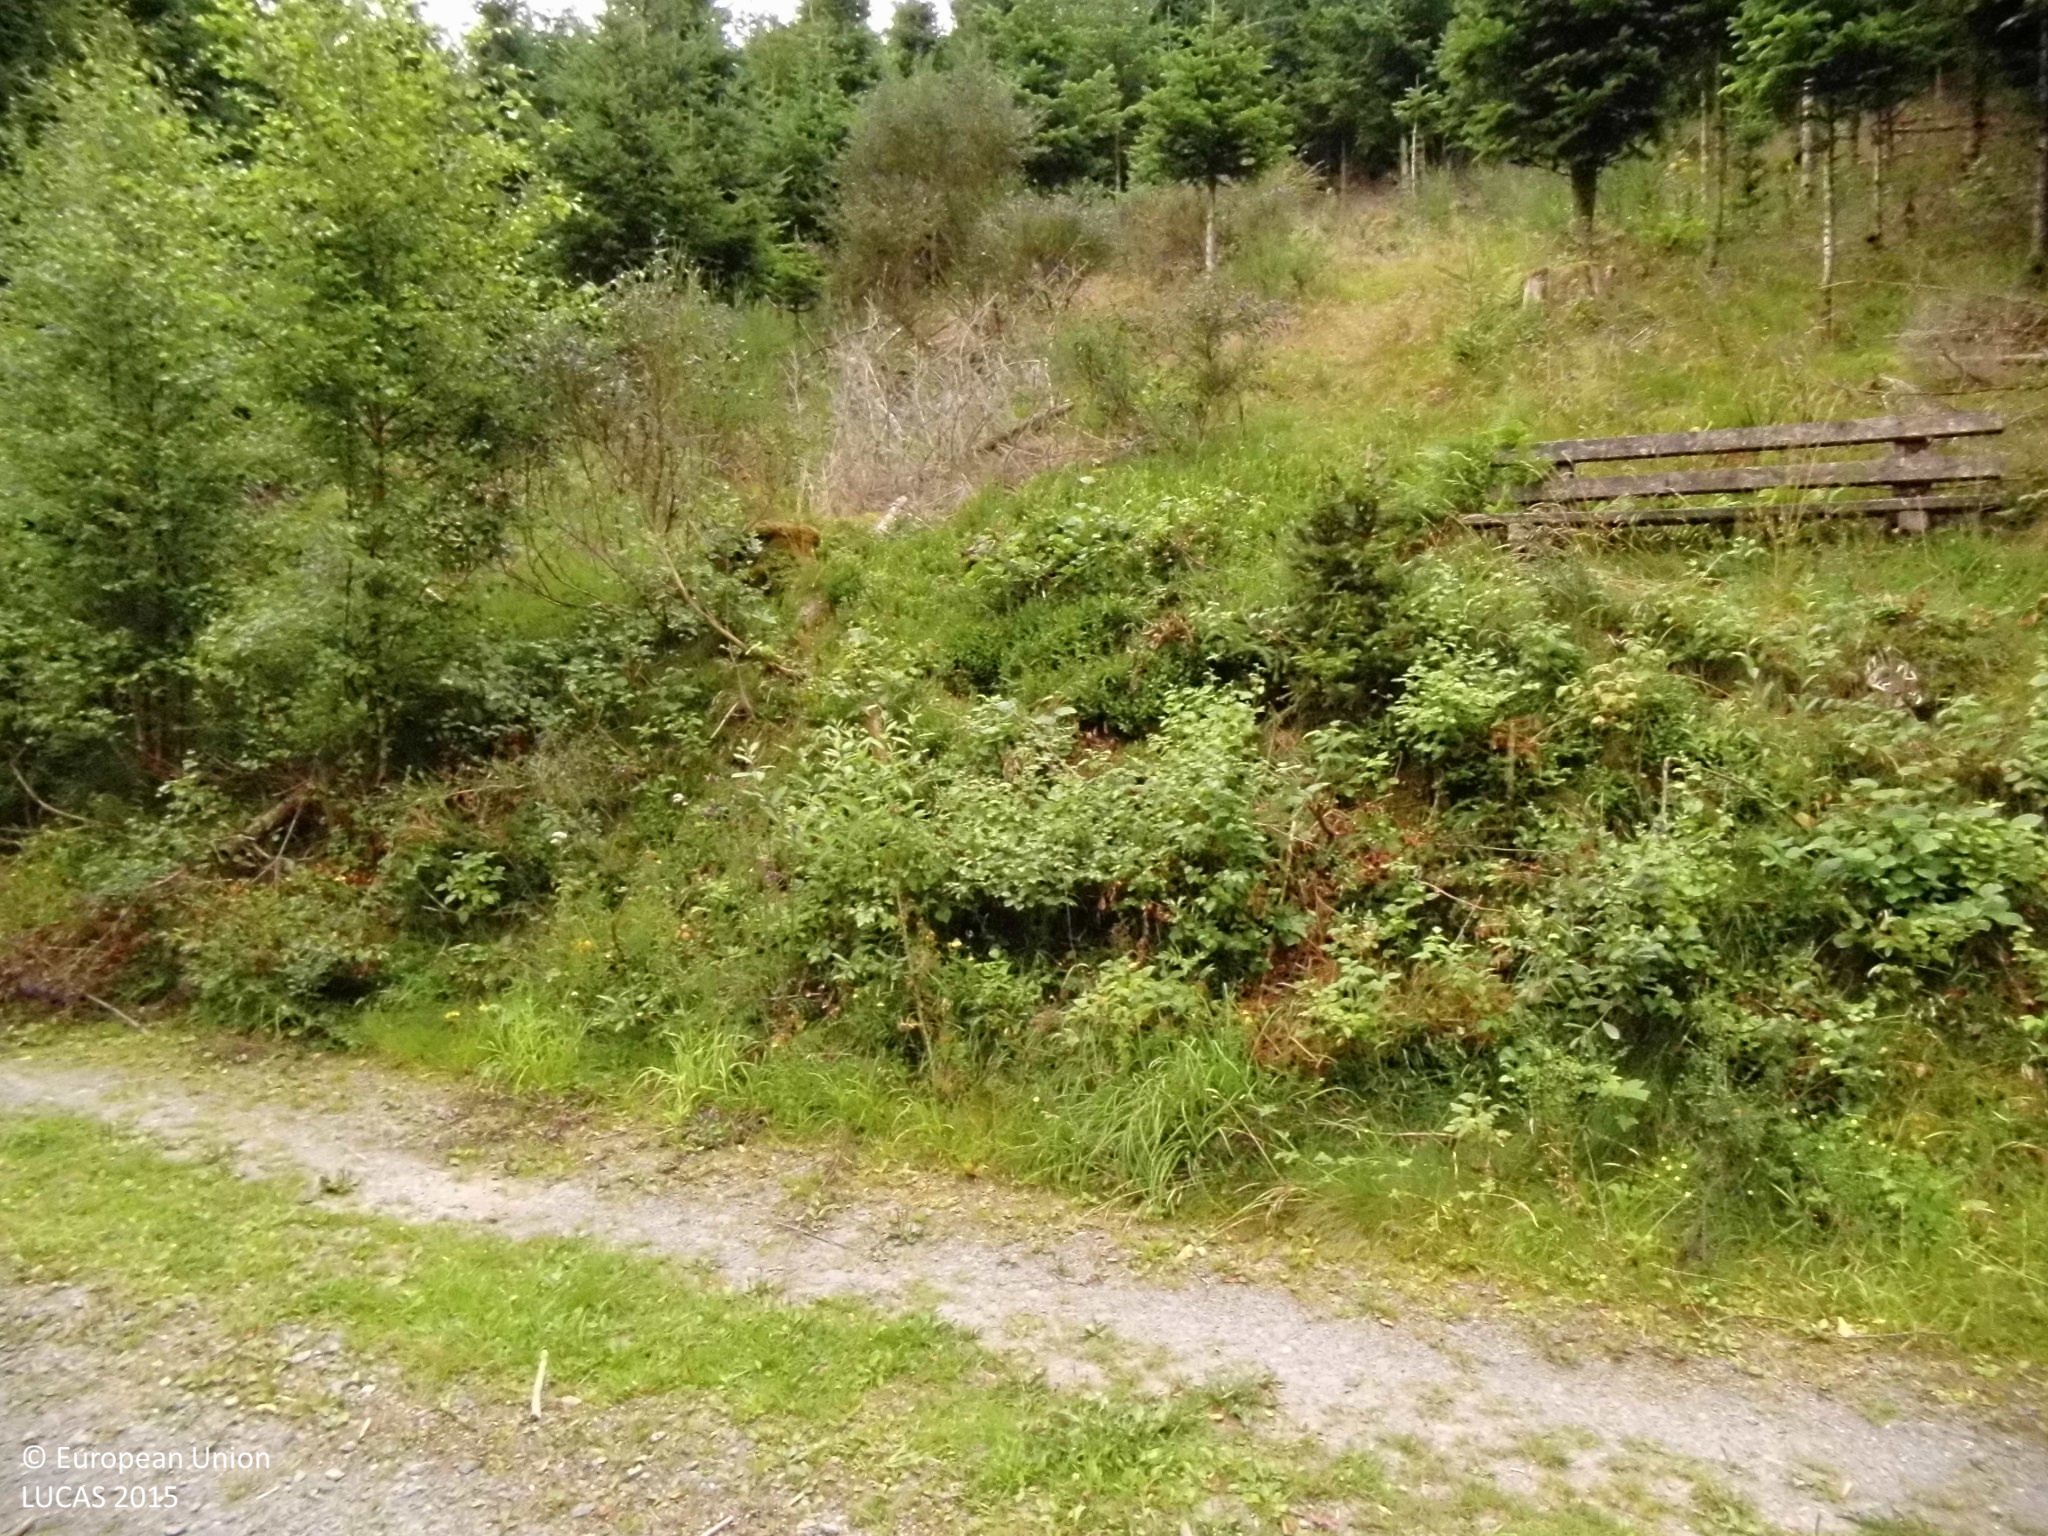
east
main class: Grassland
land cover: Grassland without tree/shrub cover
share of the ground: > 75 %
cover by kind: herbaceous plants 100 %
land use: Agriculture (excluding fallow land and kitchen gardens)
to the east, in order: Grassland without tree/shrub cover; Shrubland without tree cover; Fences; Shruby margins; Tracks; Groves; Spruce dominated coniferous woodland; Tracks; Shruby margins; Spruce dominated coniferous woodland; Rivers and streams; Grassland without tree/shrub cover; Broadleaved woodland
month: August
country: DE
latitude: 51.1627
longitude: 8.4417
